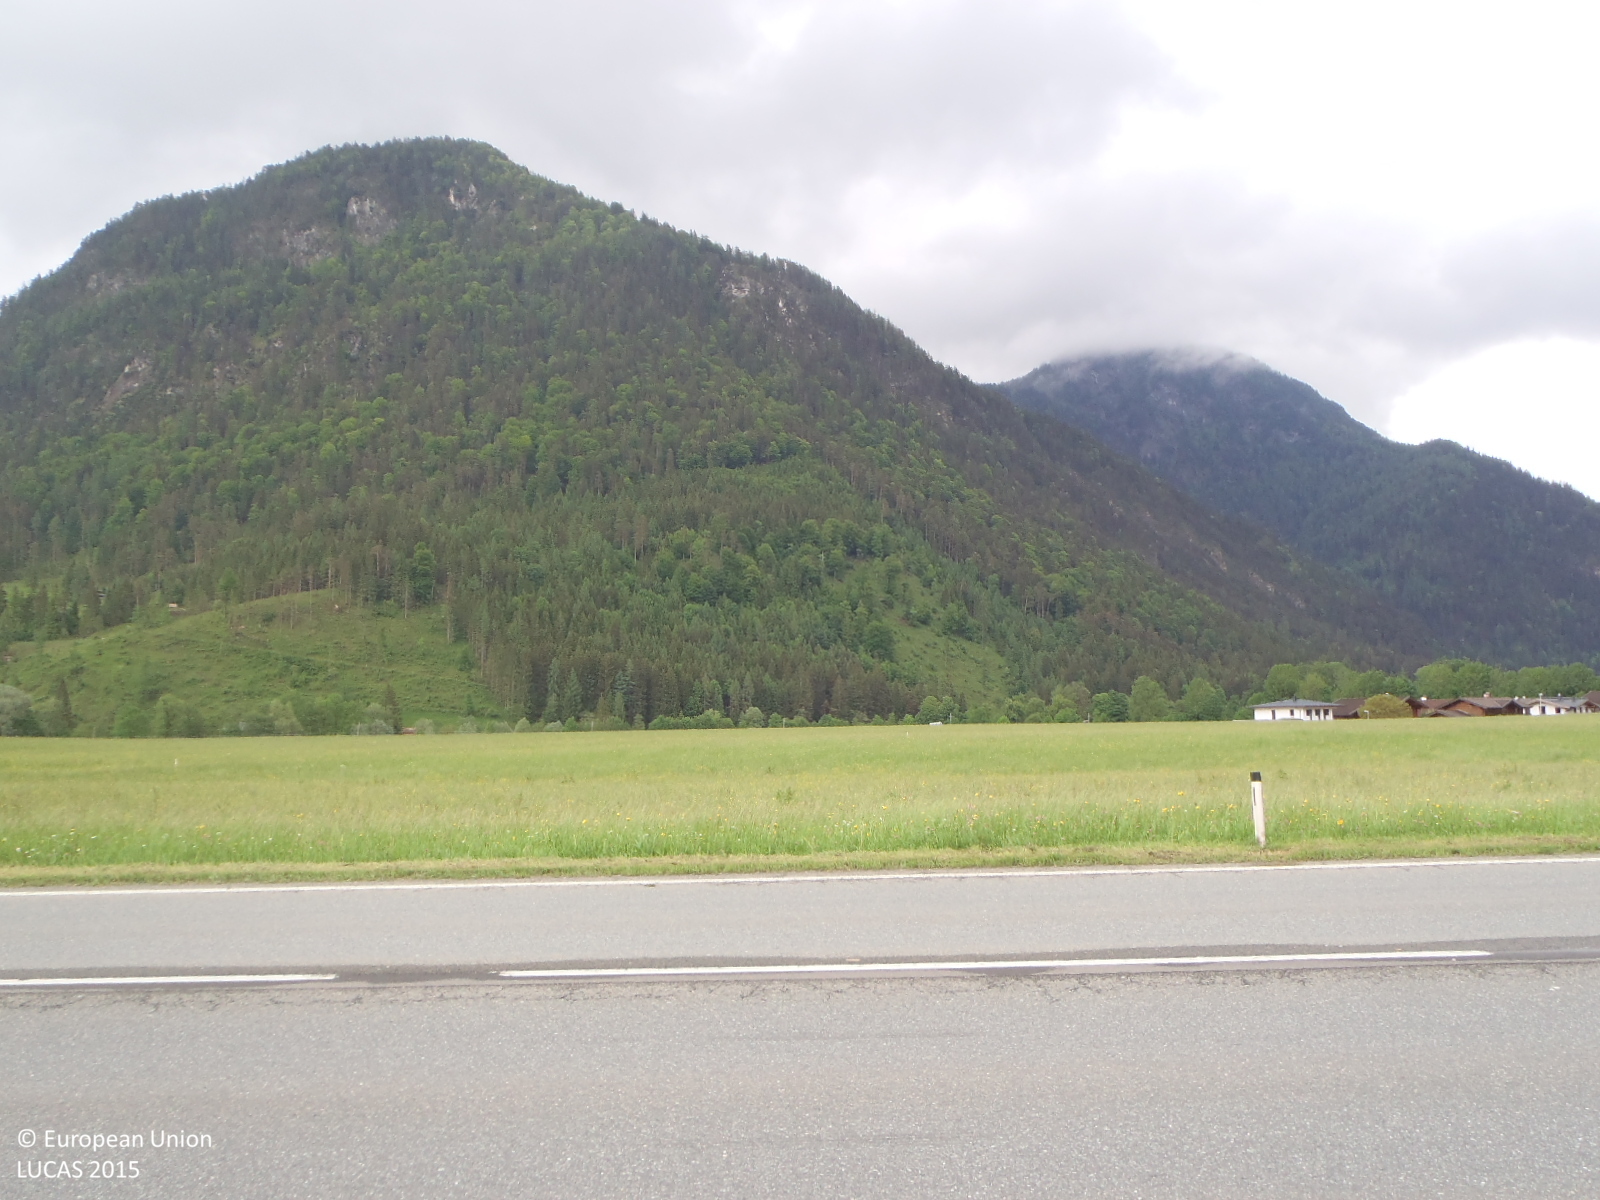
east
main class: Grassland
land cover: Grassland without tree/shrub cover
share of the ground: > 75 %
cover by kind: herbaceous plants 100 %
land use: Agriculture (excluding fallow land and kitchen gardens)
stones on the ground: < 10 %
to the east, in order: Grassland without tree/shrub cover; Ditches and canals; Grassland without tree/shrub cover; Ditches and canals; Grassland without tree/shrub cover; Paved roads, cycling and walking lanes; Grass margins; Paved roads, cycling and walking lanes; Grassland without tree/shrub cover
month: May
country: AT
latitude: 47.5783
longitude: 12.6972
